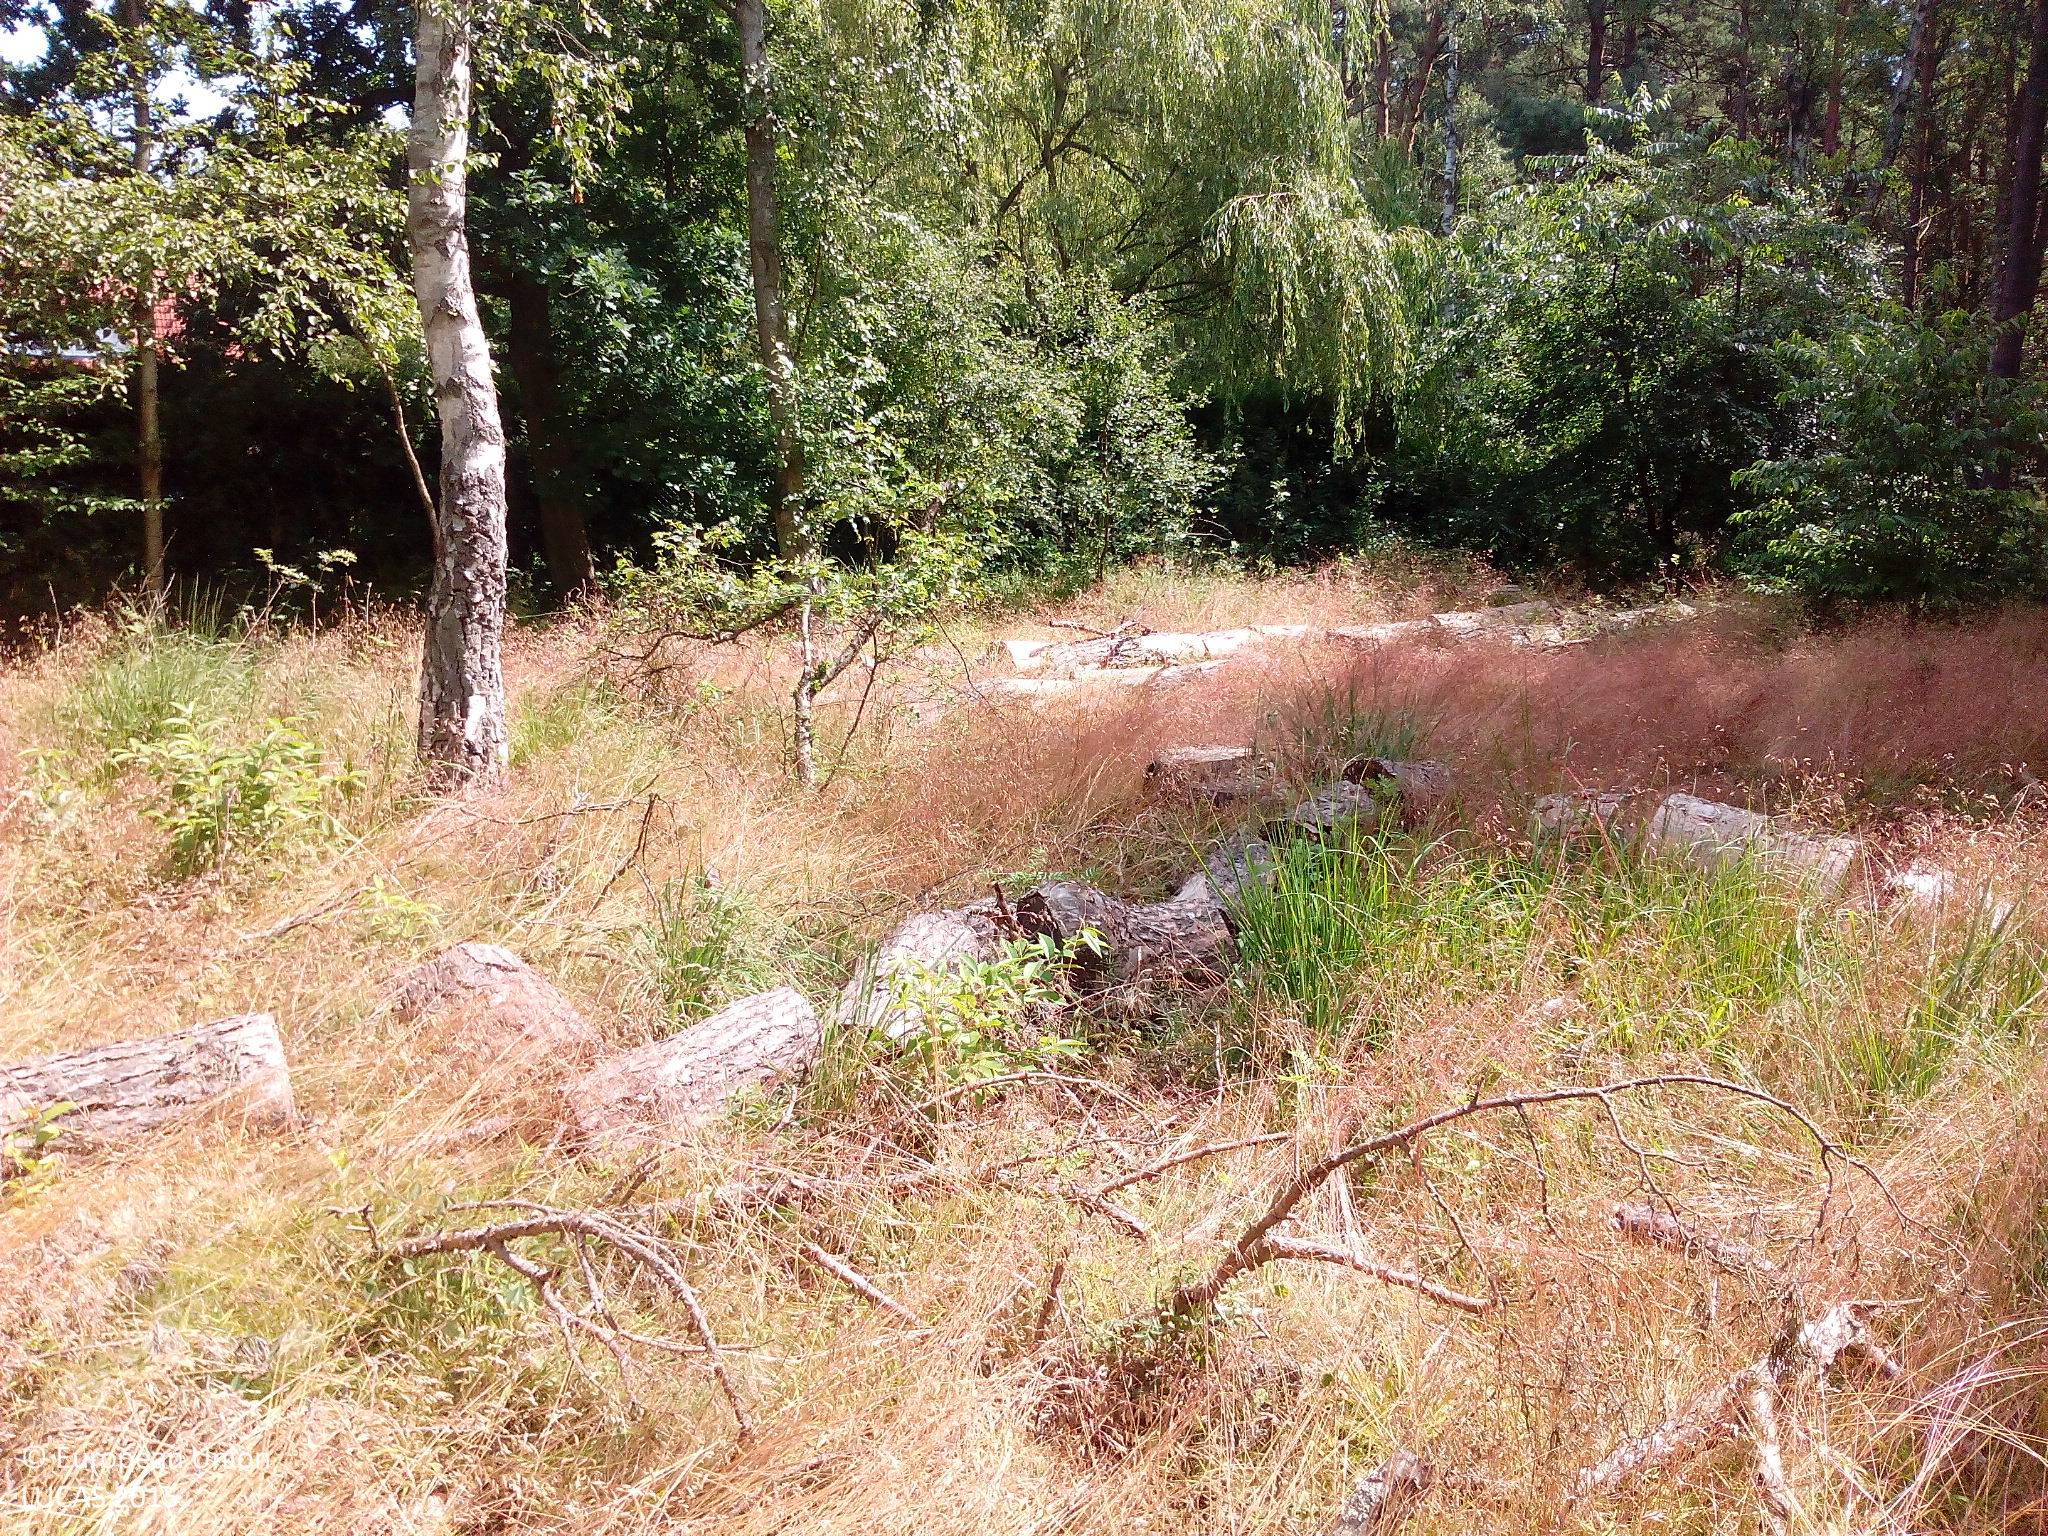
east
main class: Woodland
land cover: Broadleaved woodland
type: mesophytic deciduous forest
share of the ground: 50 - 75 %
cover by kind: broadleaved forest trees 60 %, herbaceous plants 35 %, coniferous forest trees 5 %
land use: Semi-natural and natural areas not in use
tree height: > 5 m
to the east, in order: Broadleaved woodland; Ditches and canals; Pine dominated mixed woodland; Spontaneously vegetated surfaces; Tracks; Grass margins; Shrubland without tree cover; Ditches and canals; Fences; Broadleaved woodland; Fences; Ditches and canals; Pine dominated mixed woodland; Ditches and canals; Pine dominated mixed woodland; Broadleaved woodland
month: July
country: DE
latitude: 54.4336
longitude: 12.6659
